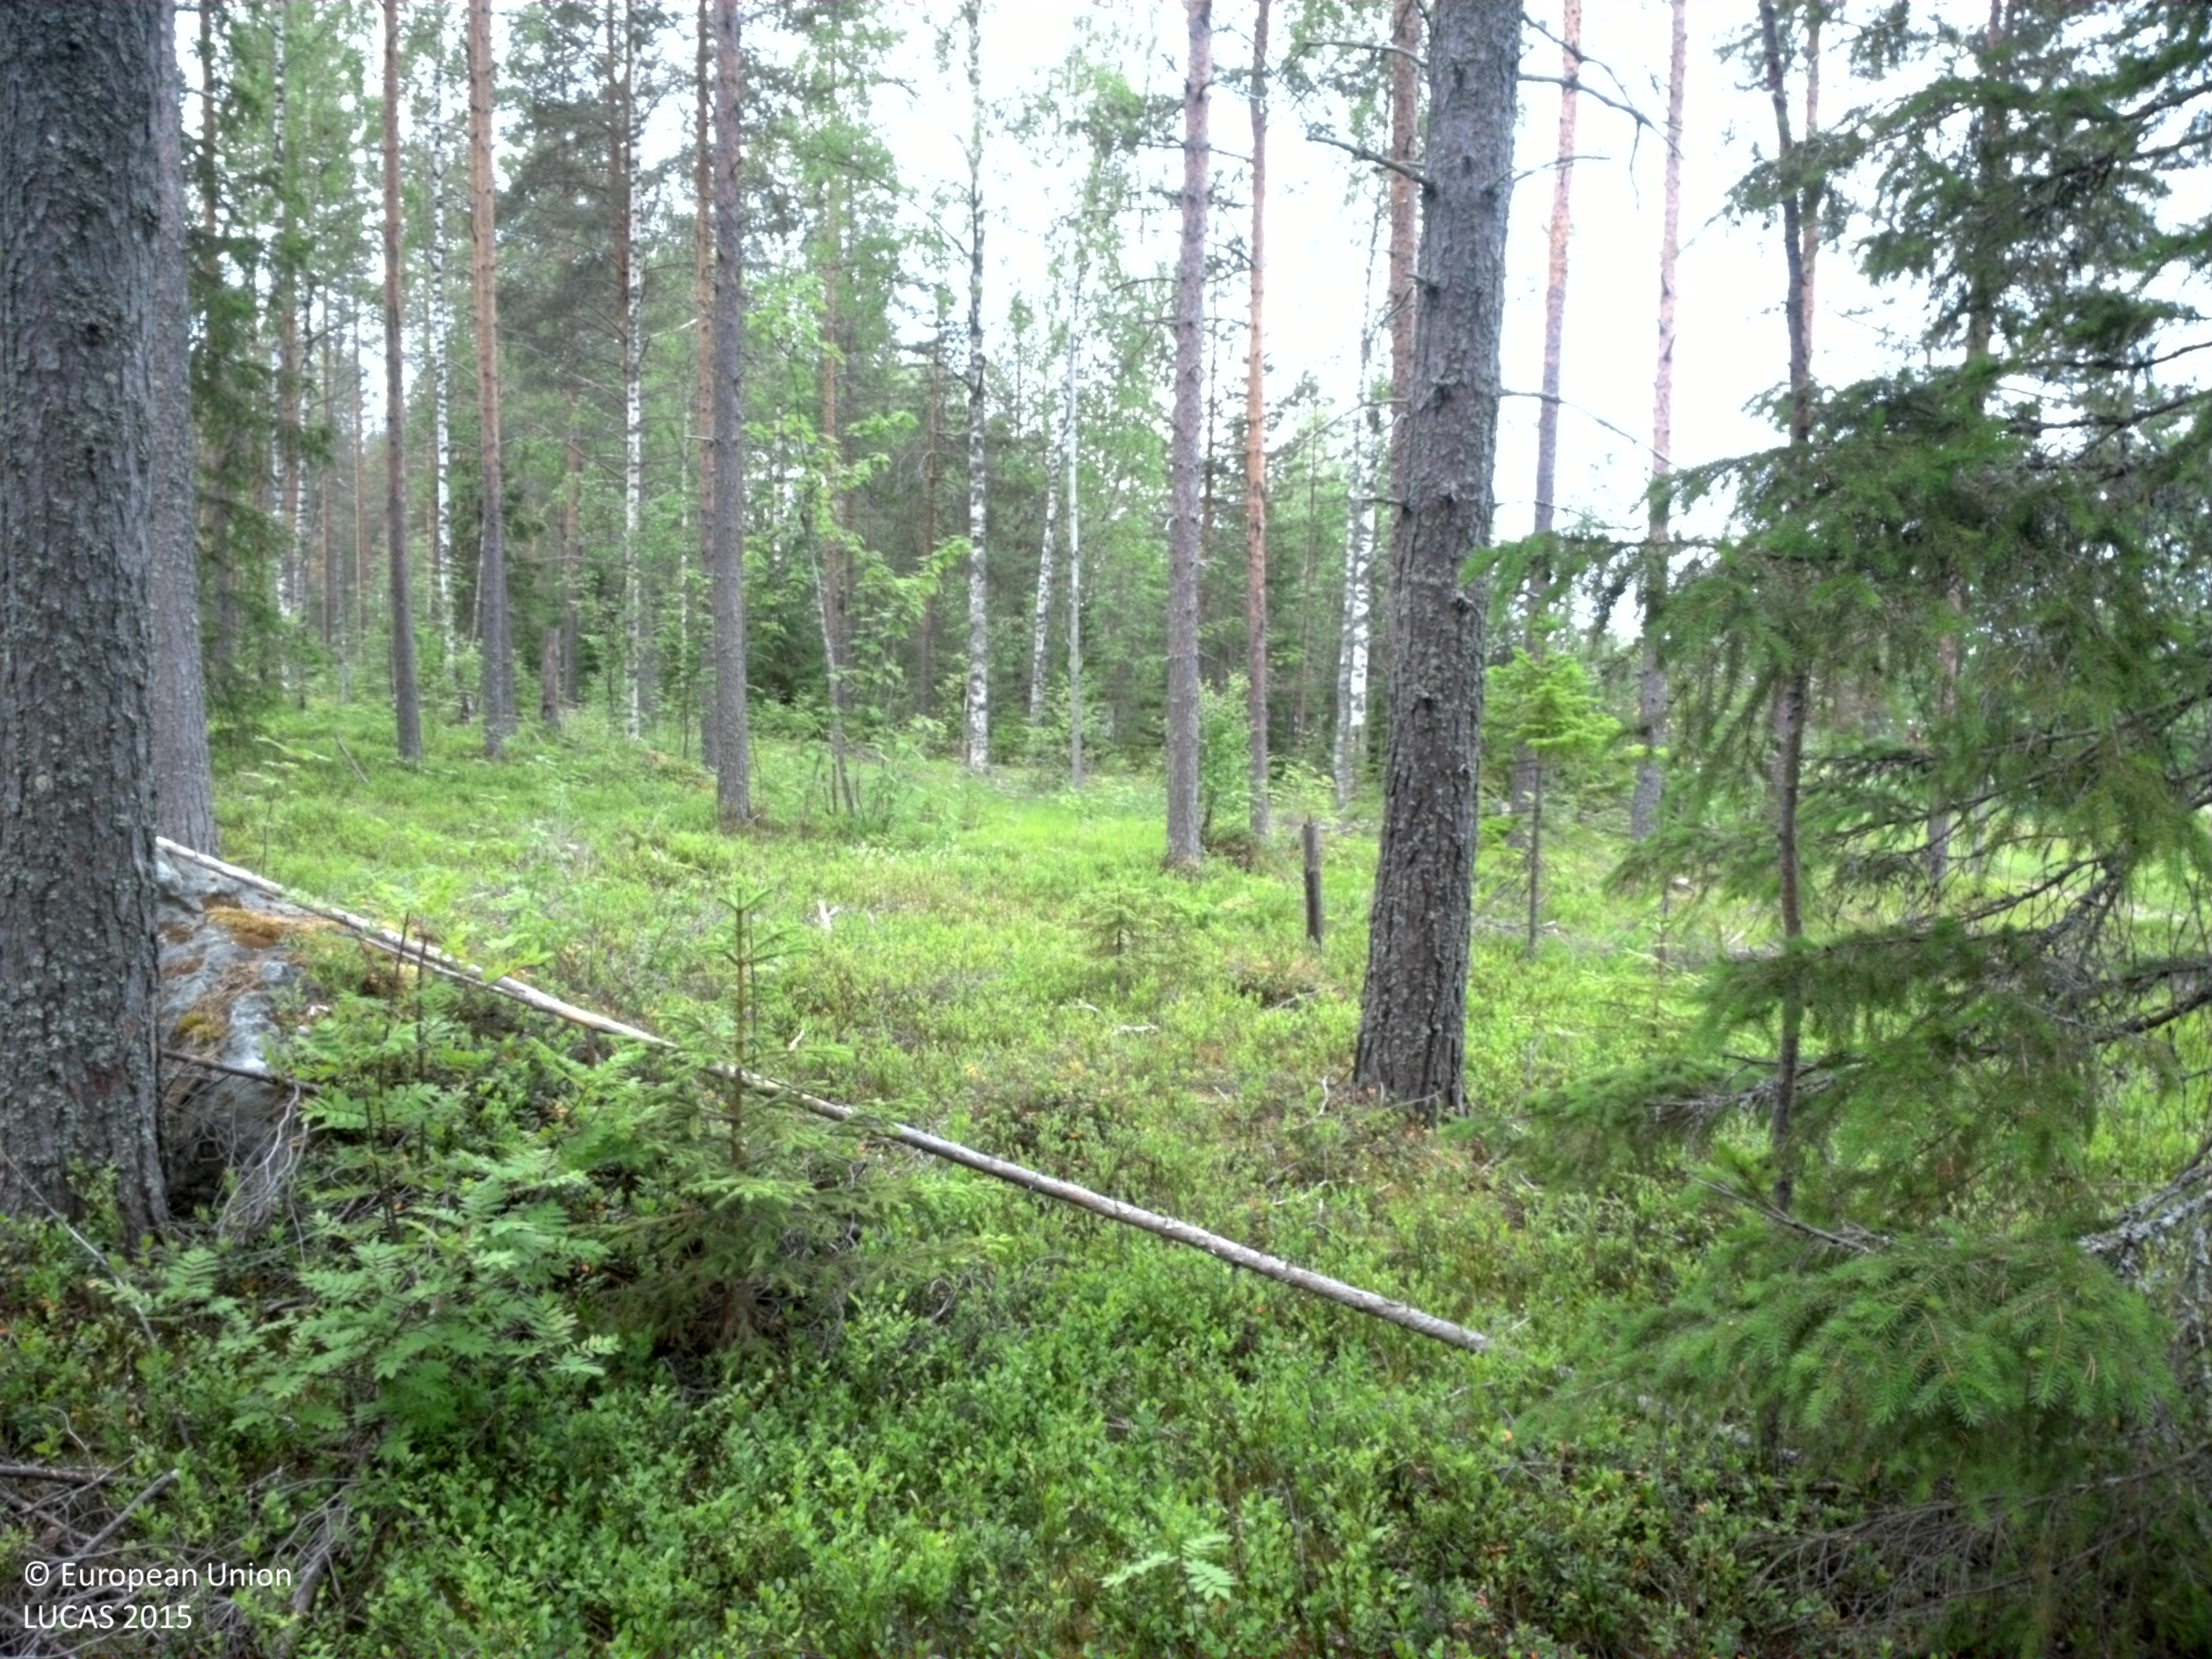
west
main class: Woodland
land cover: Pine dominated coniferous woodland
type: boreal forest
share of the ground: 25 - 50 %
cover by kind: shrubs 65 %, coniferous forest trees 30 %, broadleaved forest trees 5 %
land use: Forestry
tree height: > 5 m
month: July
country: SE
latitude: 64.4962
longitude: 20.9084
